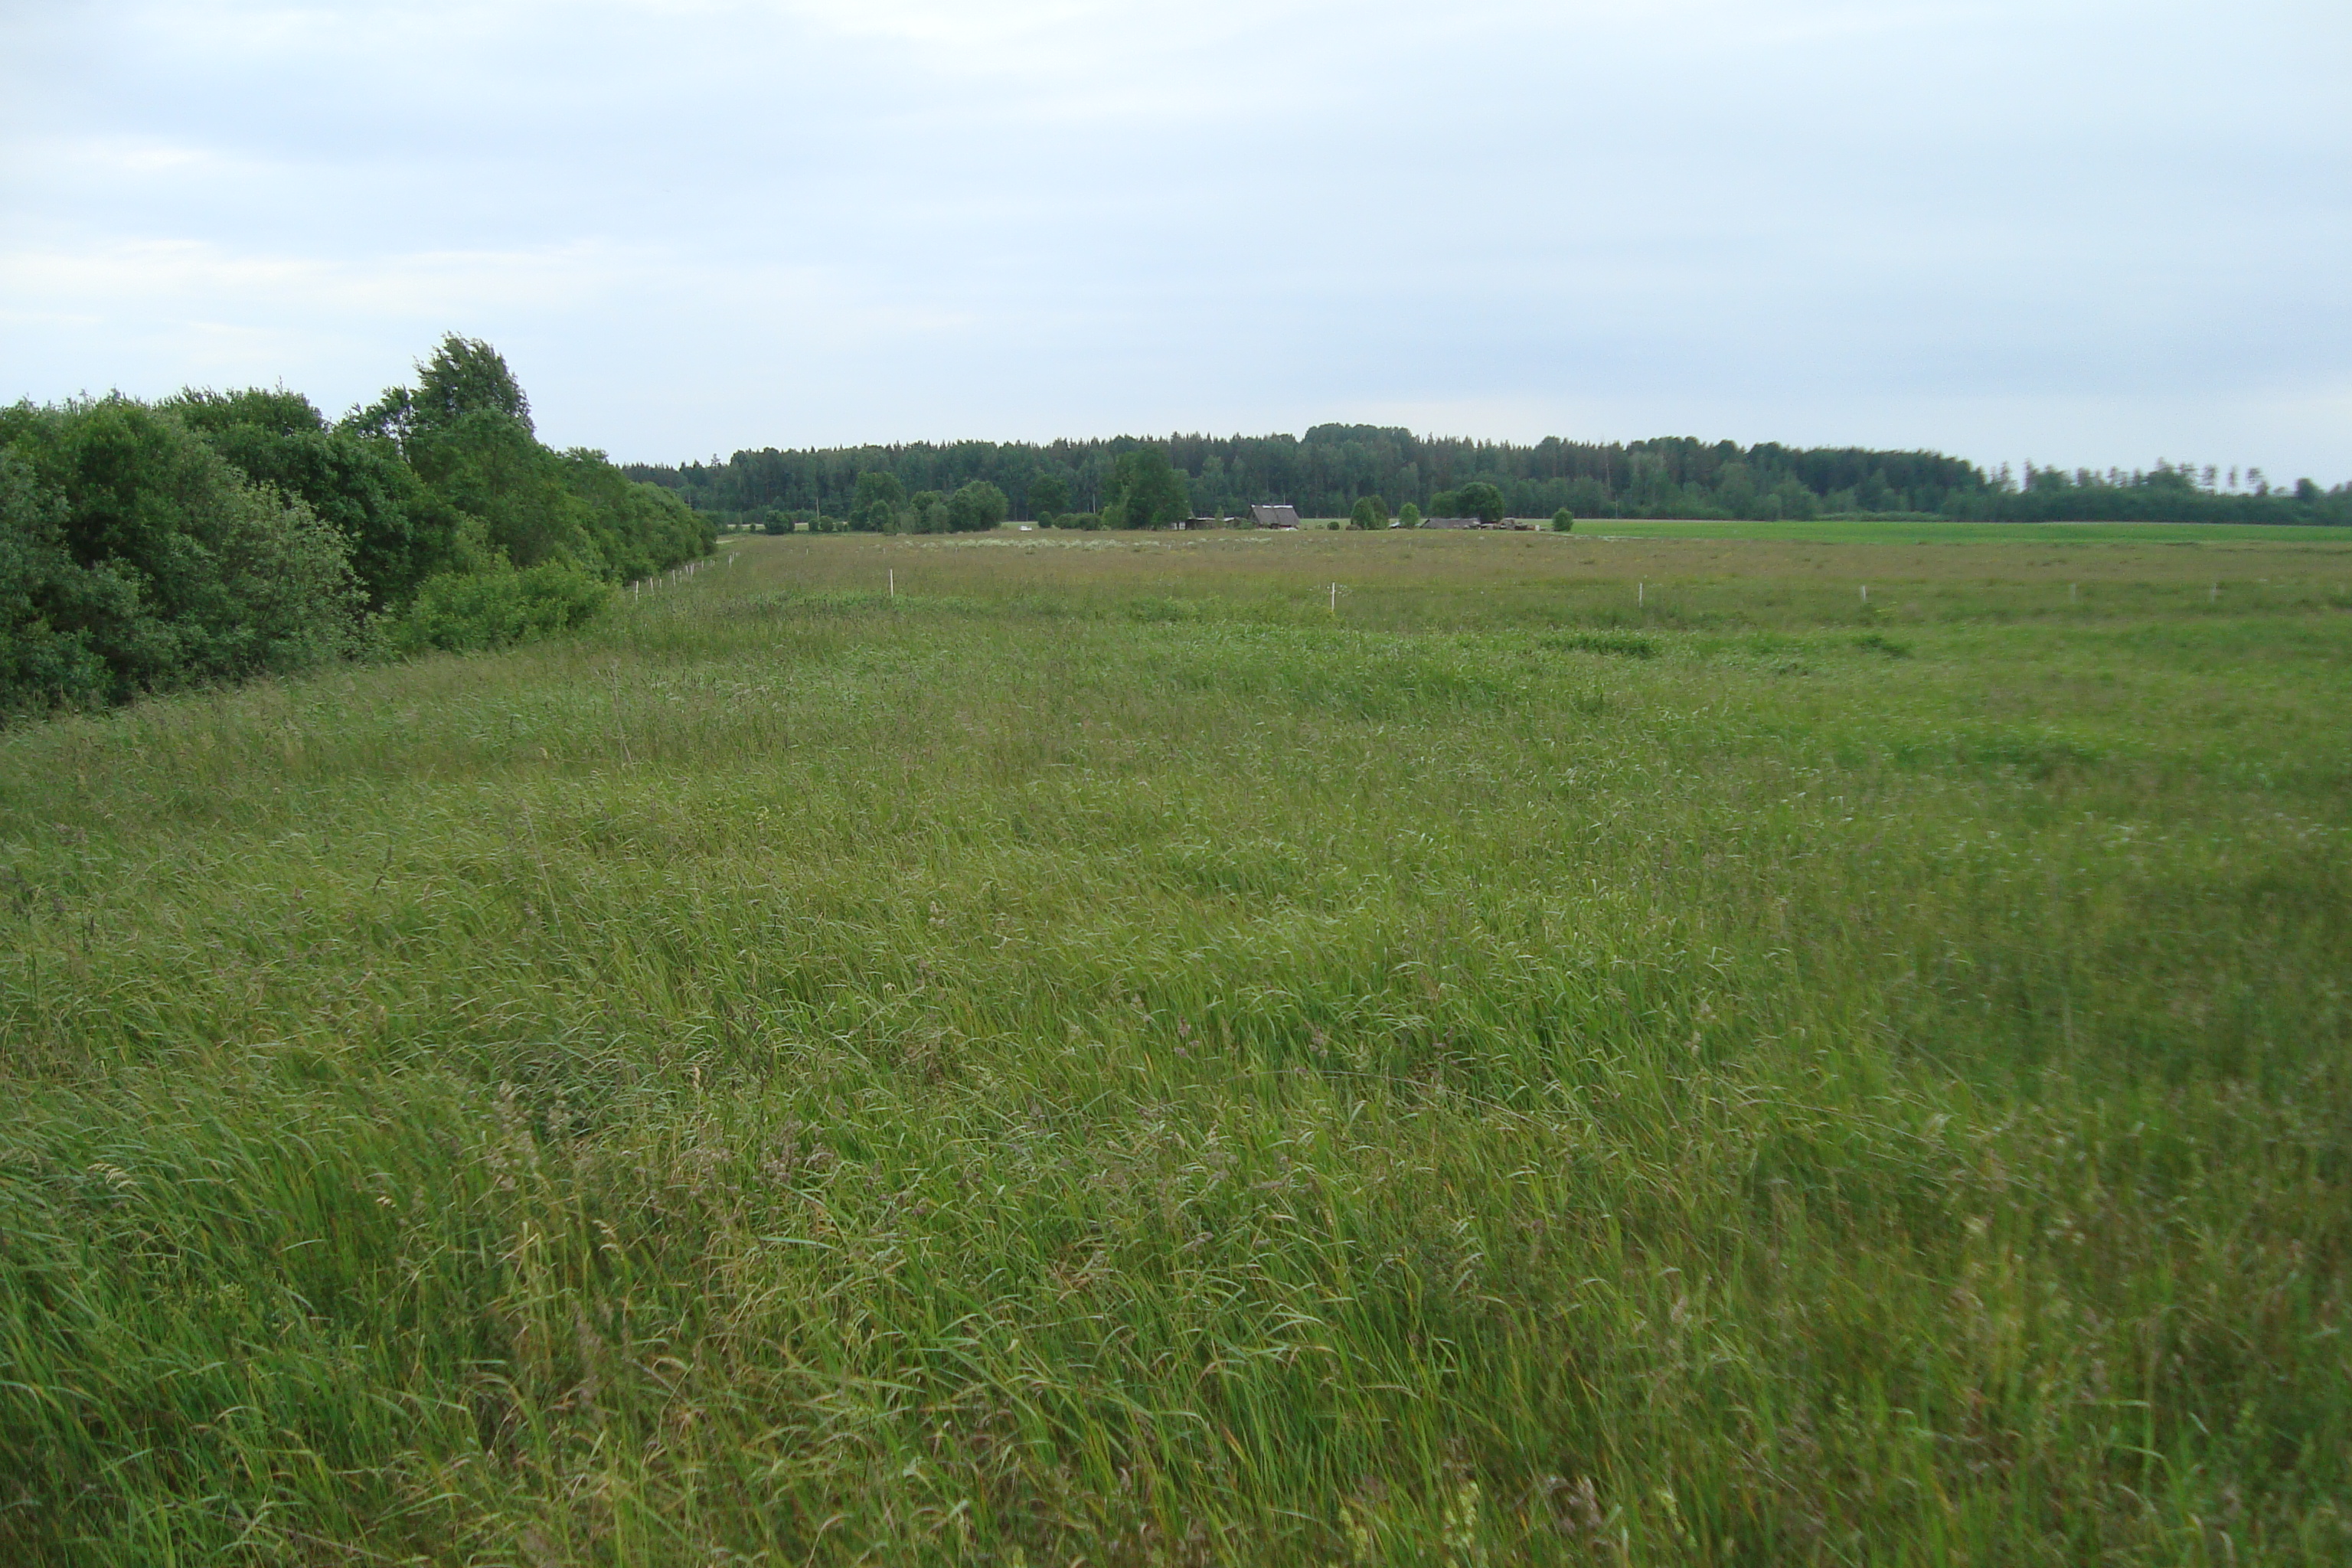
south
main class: Grassland
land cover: Grassland without tree/shrub cover
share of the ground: > 75 %
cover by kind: herbaceous plants 100 %
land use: Agriculture (excluding fallow land and kitchen gardens)
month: June
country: LV
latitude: 57.2387
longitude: 26.3952
